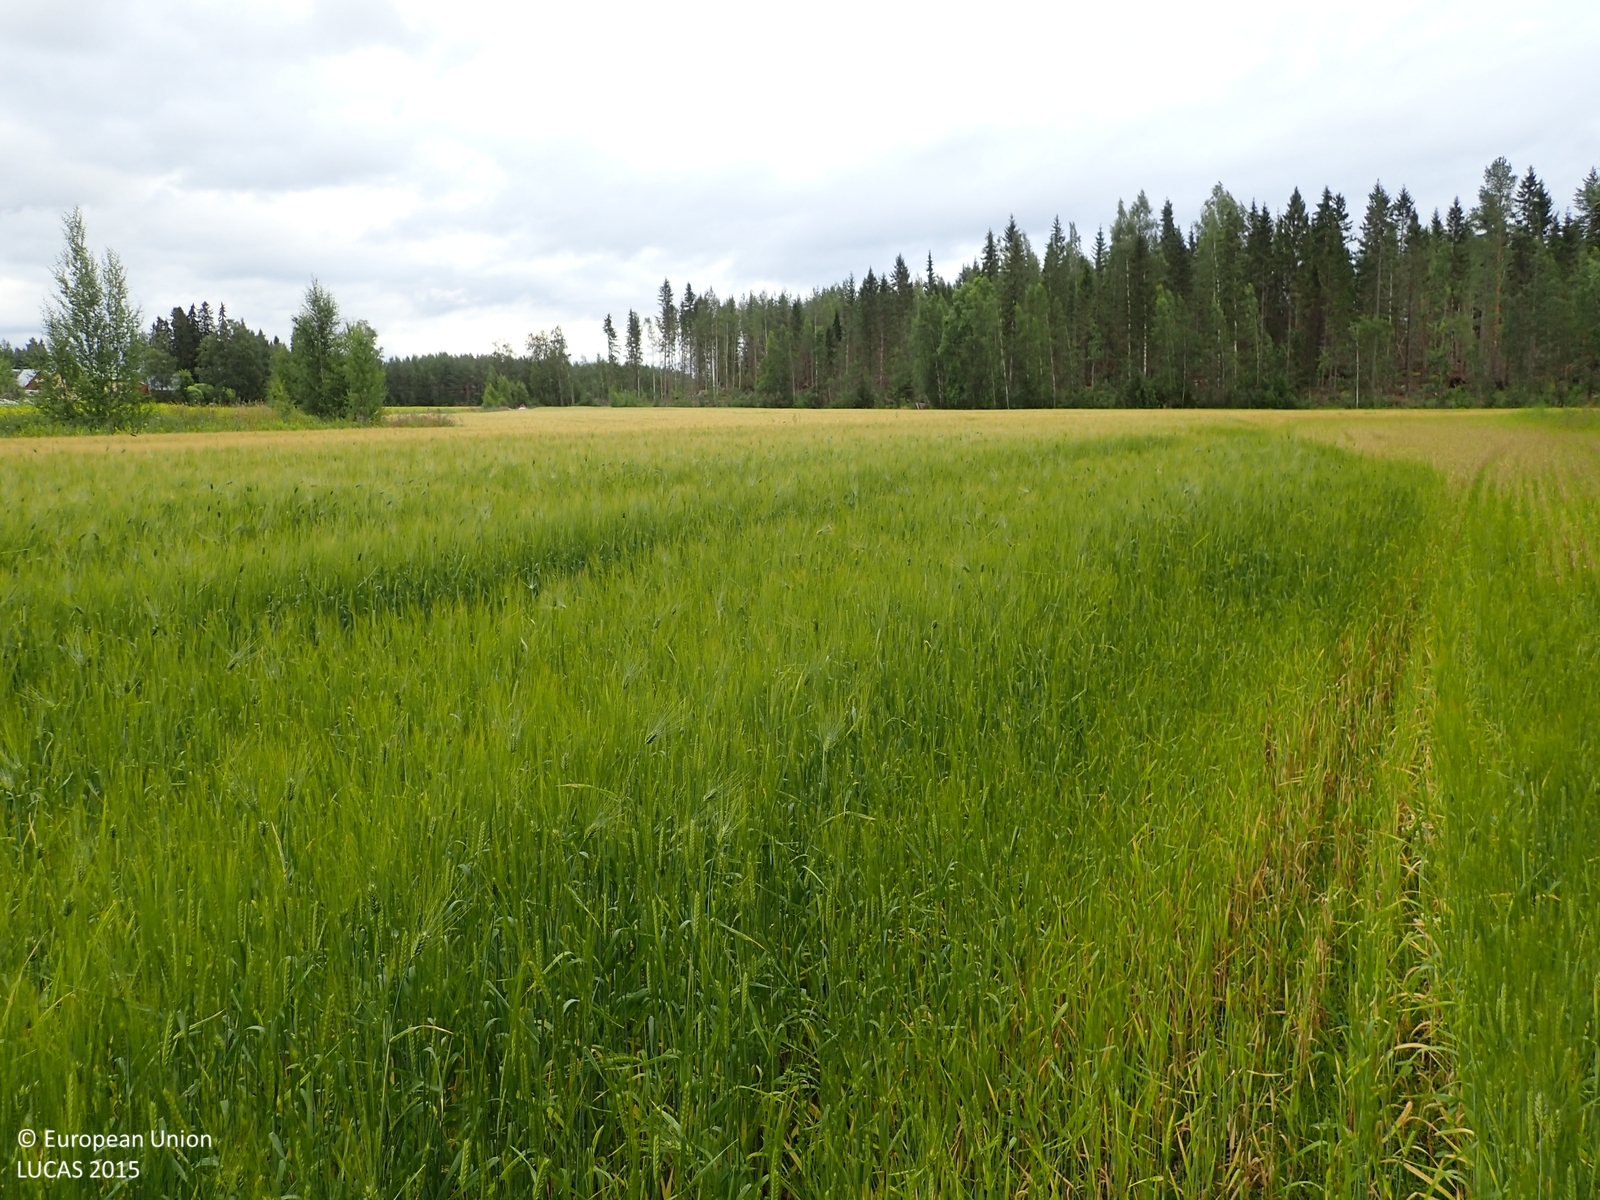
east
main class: Cropland
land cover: Barley
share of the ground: > 75 %
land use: Agriculture (excluding fallow land and kitchen gardens)
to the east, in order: Barley; Shruby margins; Ditches and canals; Spruce dominated mixed woodland
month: August
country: FI
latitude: 62.9639
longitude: 22.0952
